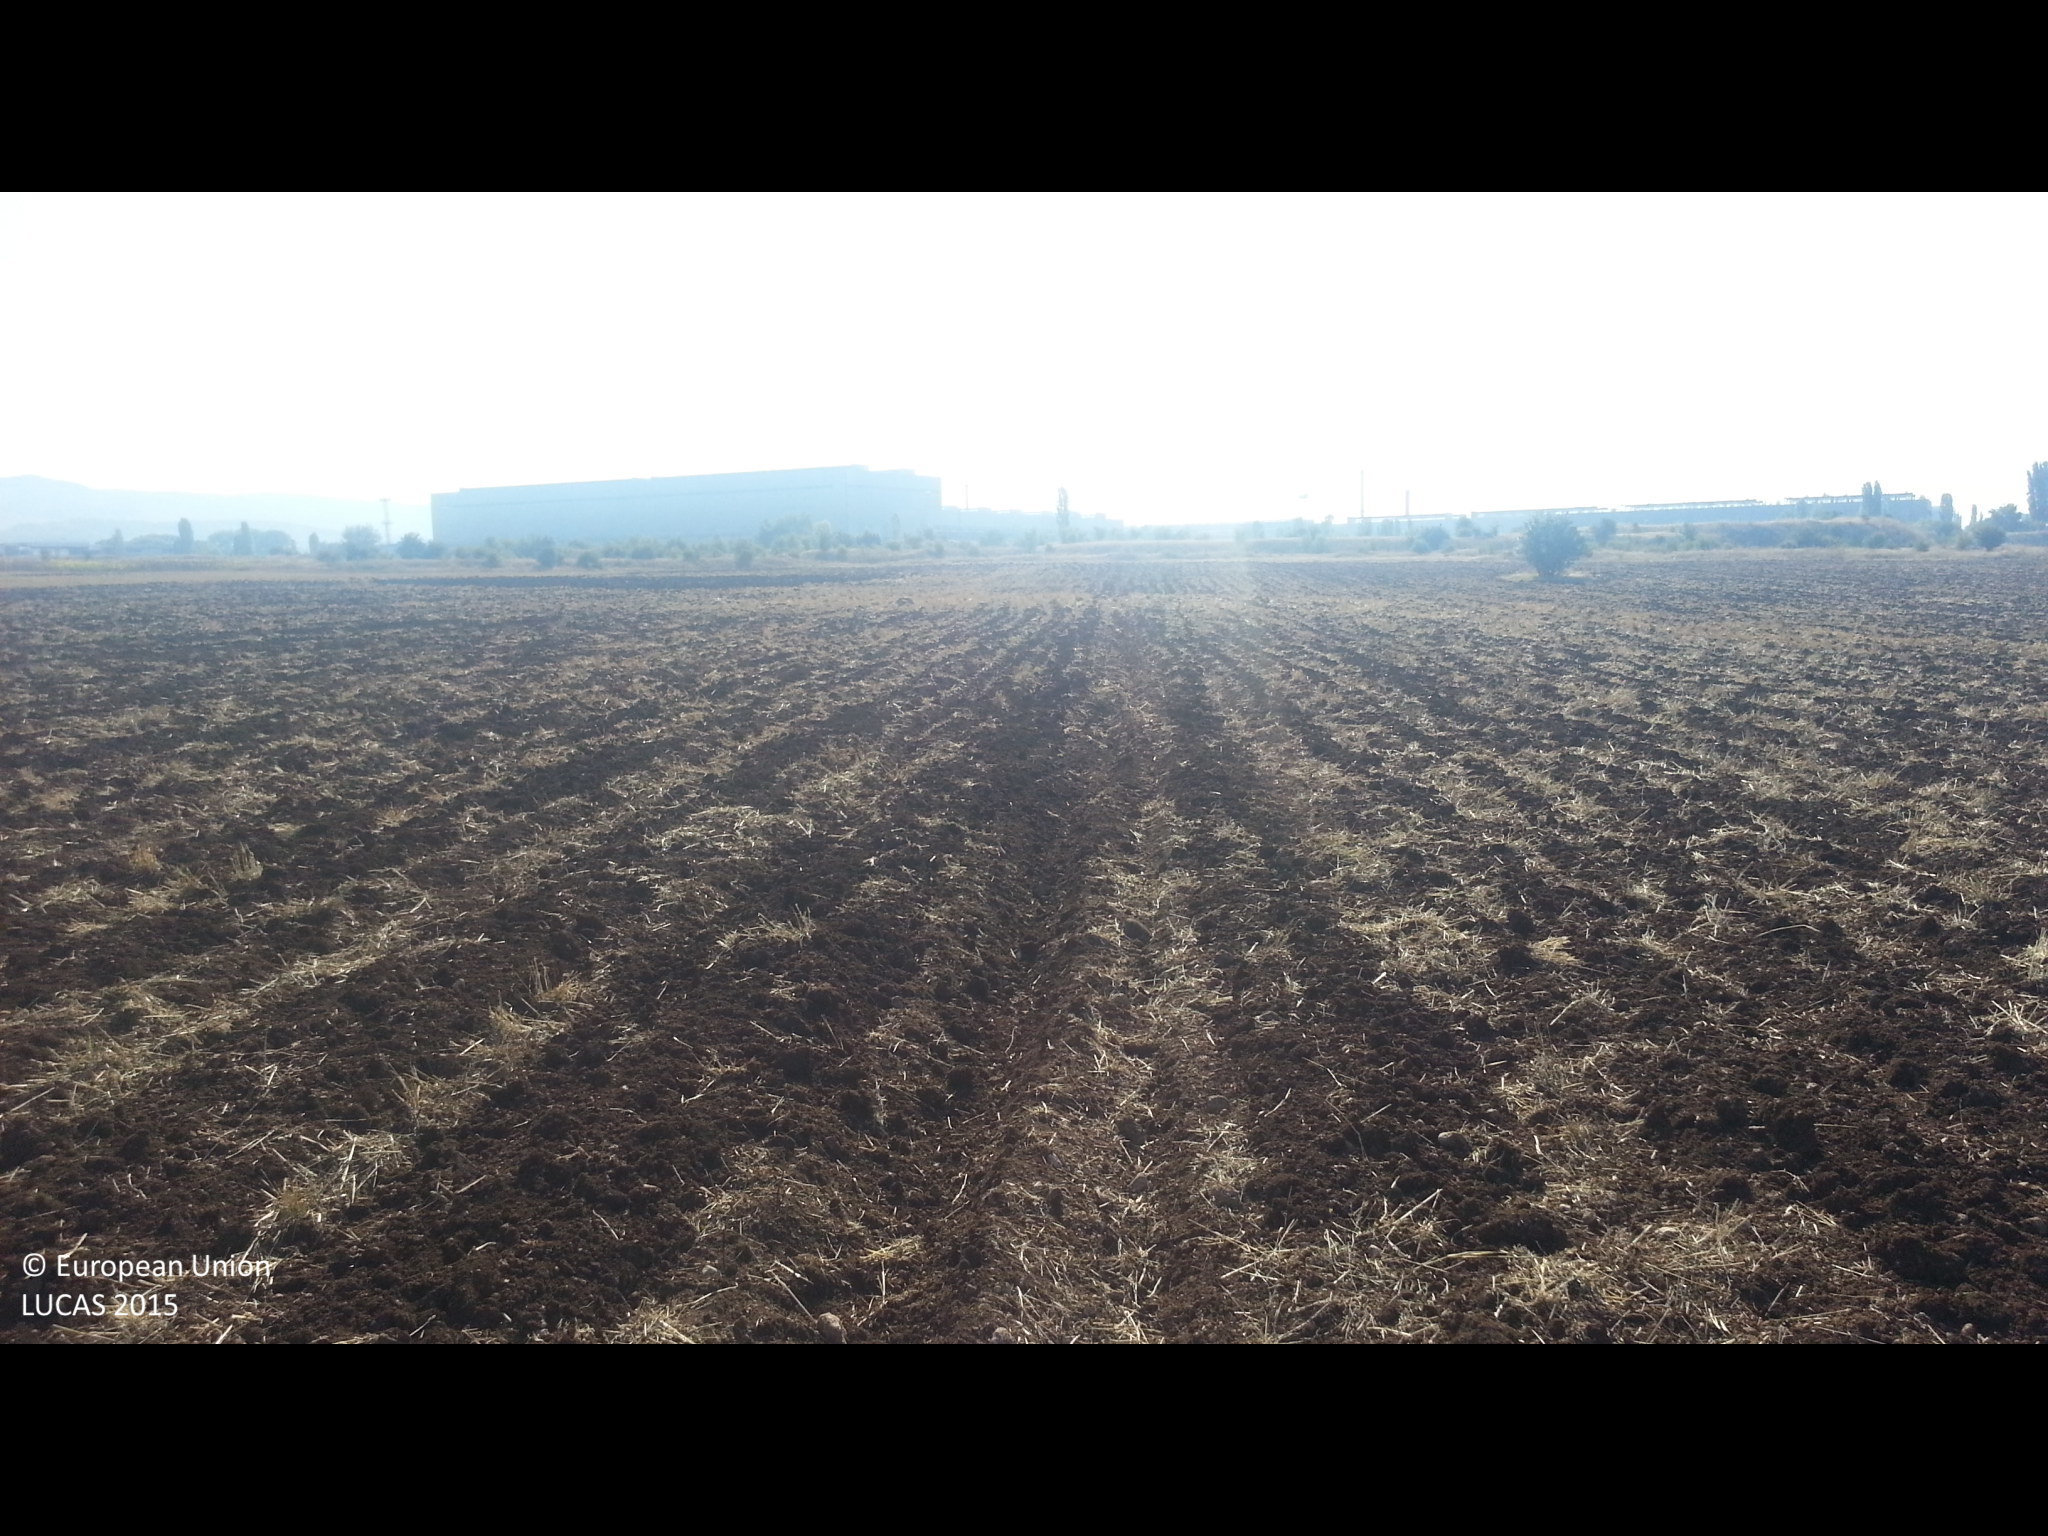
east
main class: Cropland
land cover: Common wheat
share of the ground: < 10 %
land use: Agriculture (excluding fallow land and kitchen gardens)
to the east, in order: Common wheat; Grassland with sparse tree/shrub cover
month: August
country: BG
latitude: 42.5287
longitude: 22.9688
